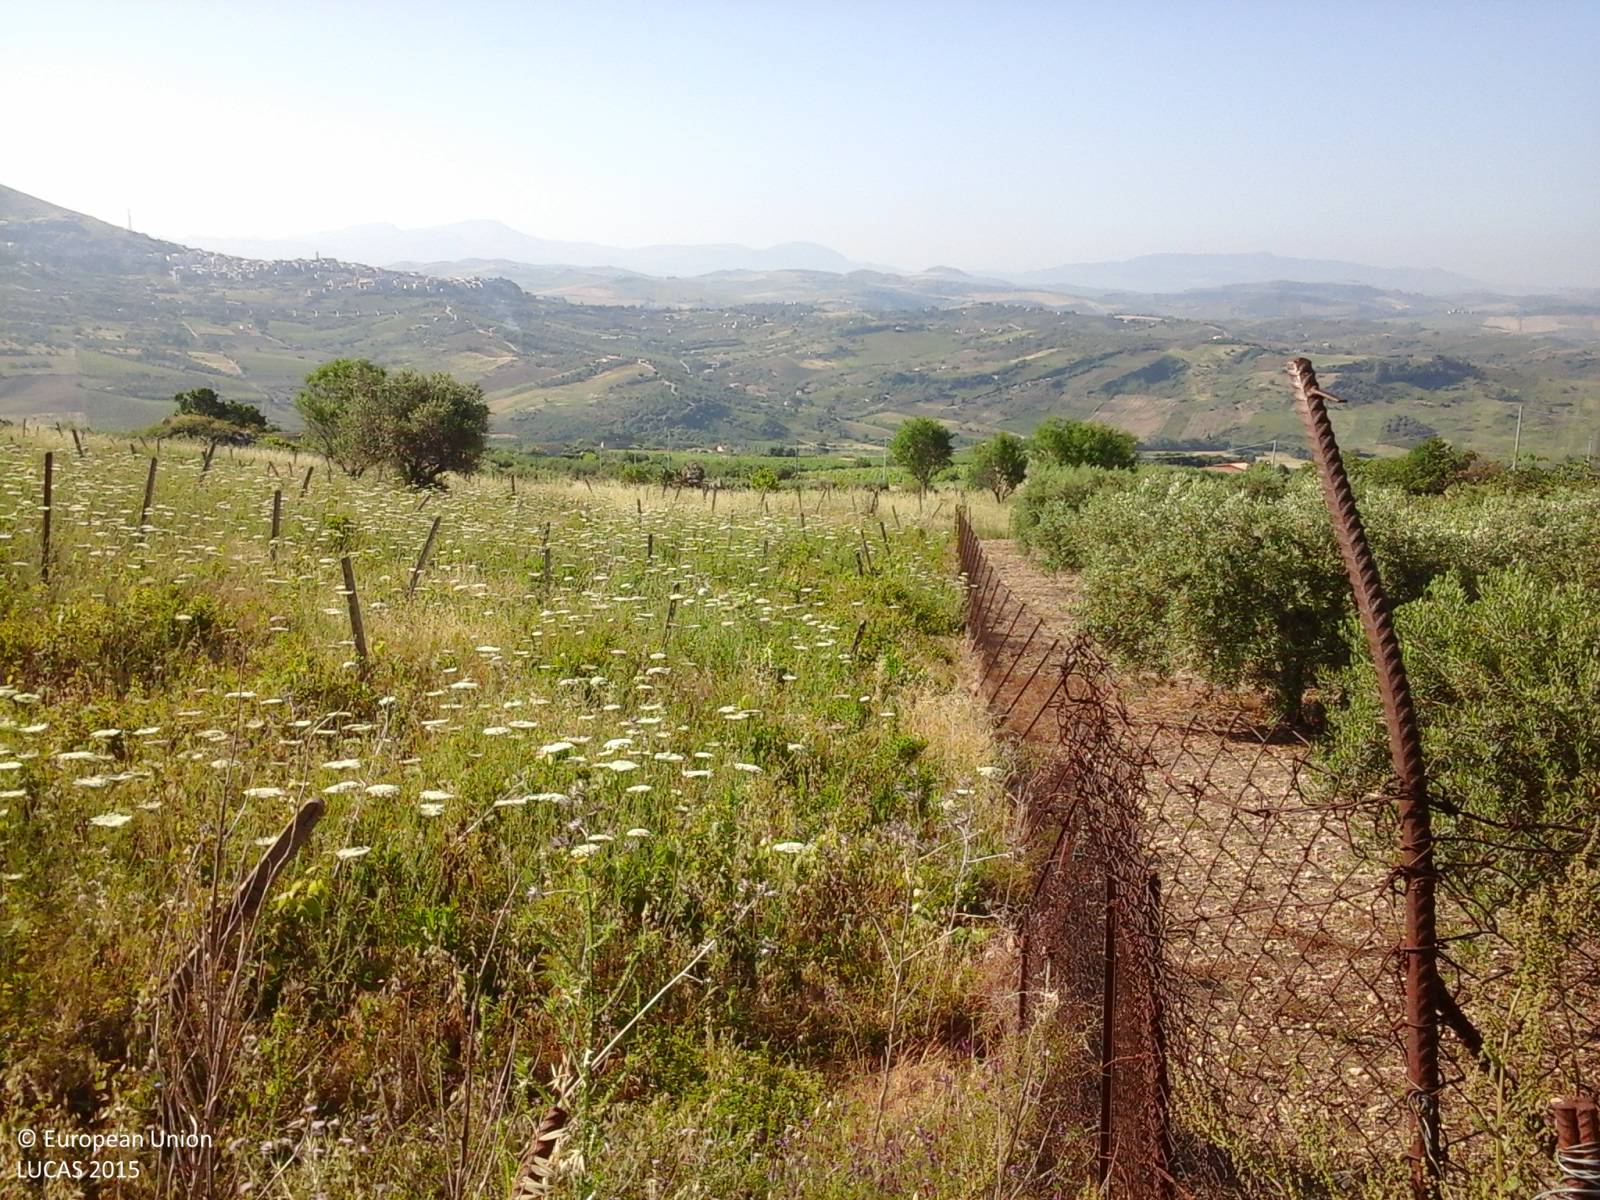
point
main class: Grassland
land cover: Grassland with sparse tree/shrub cover
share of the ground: > 75 %
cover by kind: herbaceous plants 95 %, broadleaved forest trees 5 %
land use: Abandoned areas
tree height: > 5 m
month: June
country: IT
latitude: 37.9859
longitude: 13.1540
